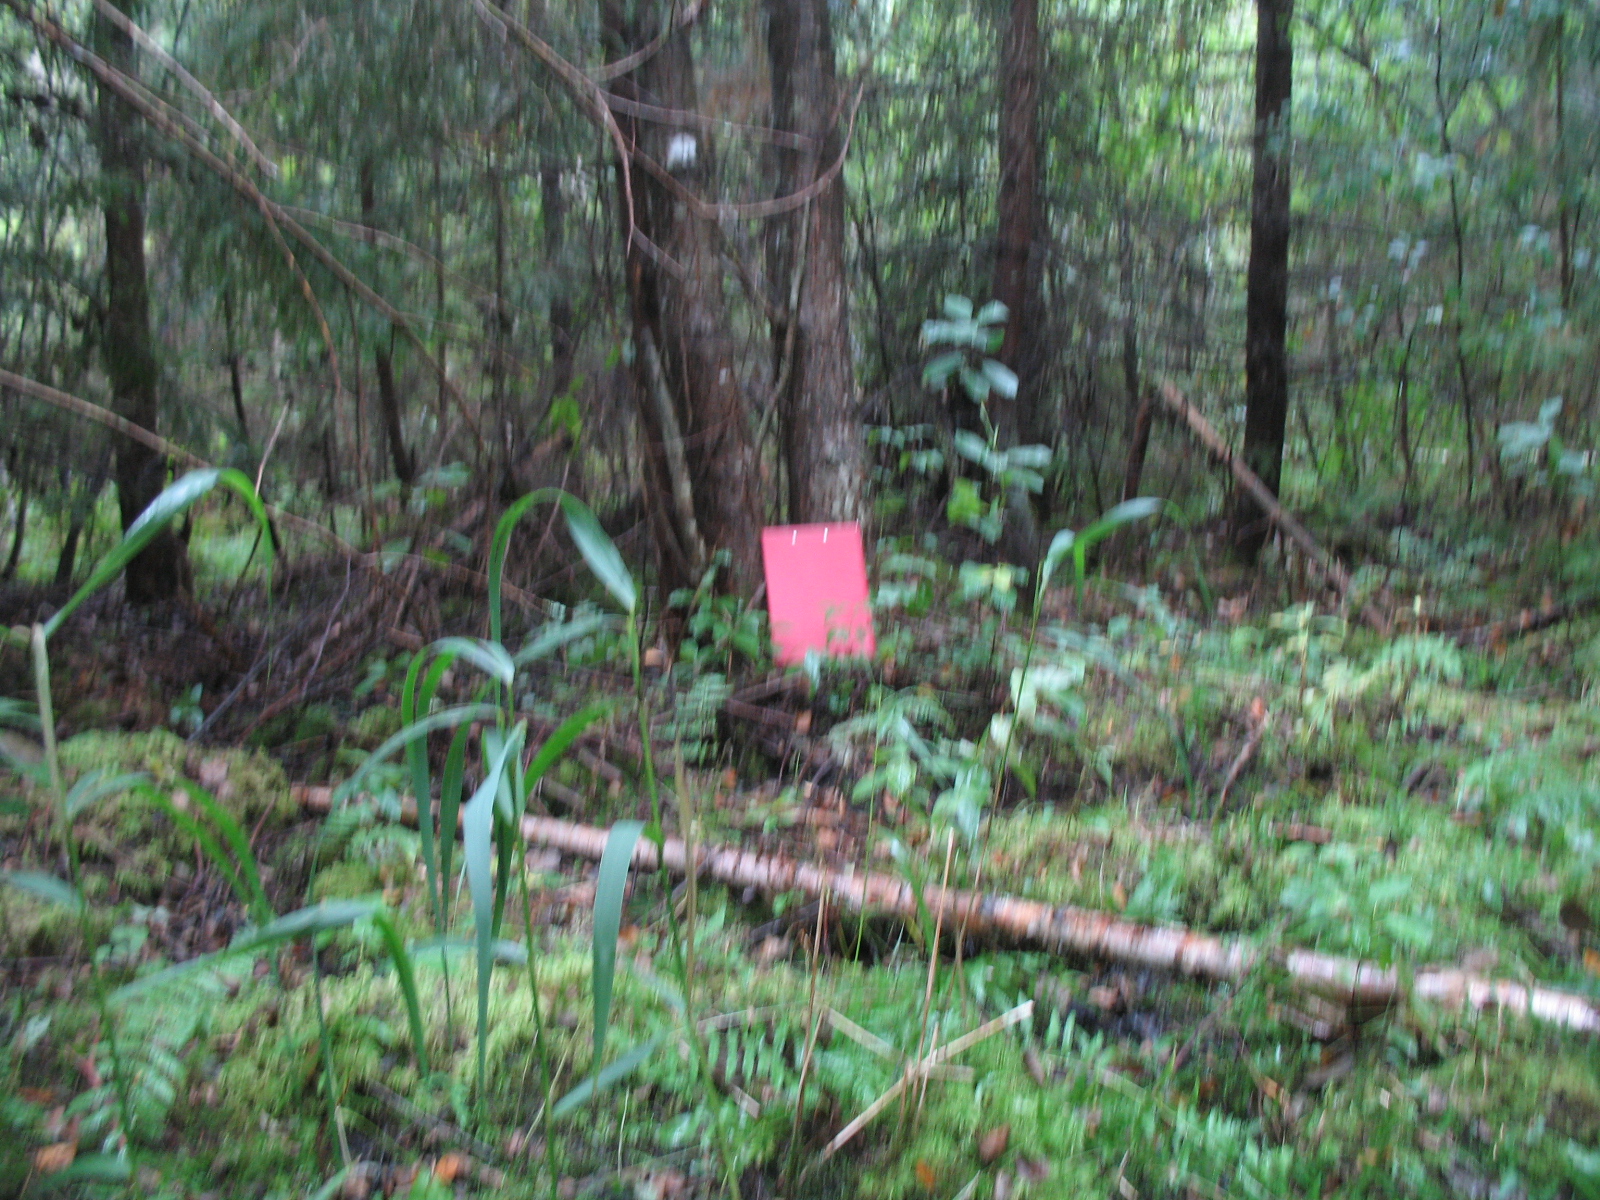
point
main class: Woodland
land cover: Spruce dominated mixed woodland
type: hemiboreal forest and nemoral coniferous forest and mixed broadleaved-coniferous forest
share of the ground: > 75 %
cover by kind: coniferous forest trees 45 %, broadleaved forest trees 40 %, herbaceous plants 10 %, lichens and mosses 5 %
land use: Forestry
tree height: > 5 m
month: September
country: LV
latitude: 56.1171
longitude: 26.2417
